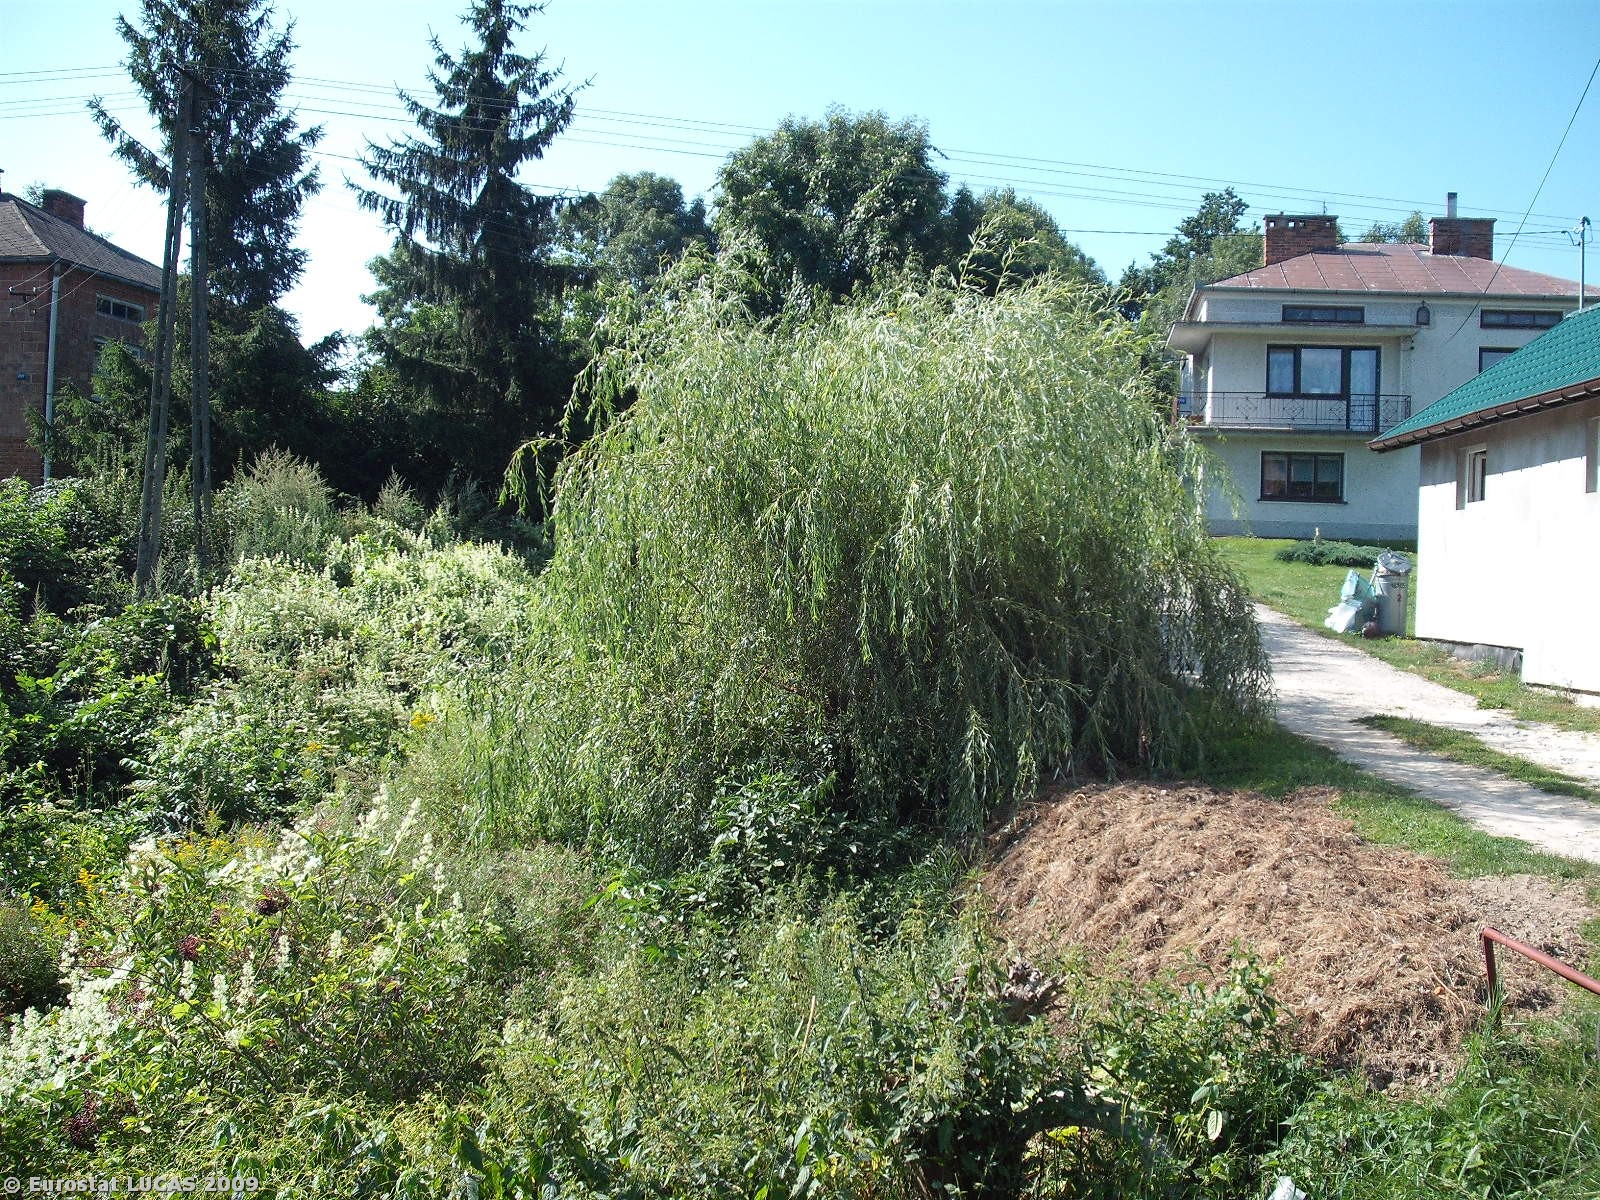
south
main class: Shrubland
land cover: Shrubland with sparse tree cover
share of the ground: > 75 %
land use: Unused
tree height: < 5 m
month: August
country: PL
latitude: 50.1926
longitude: 22.0913
